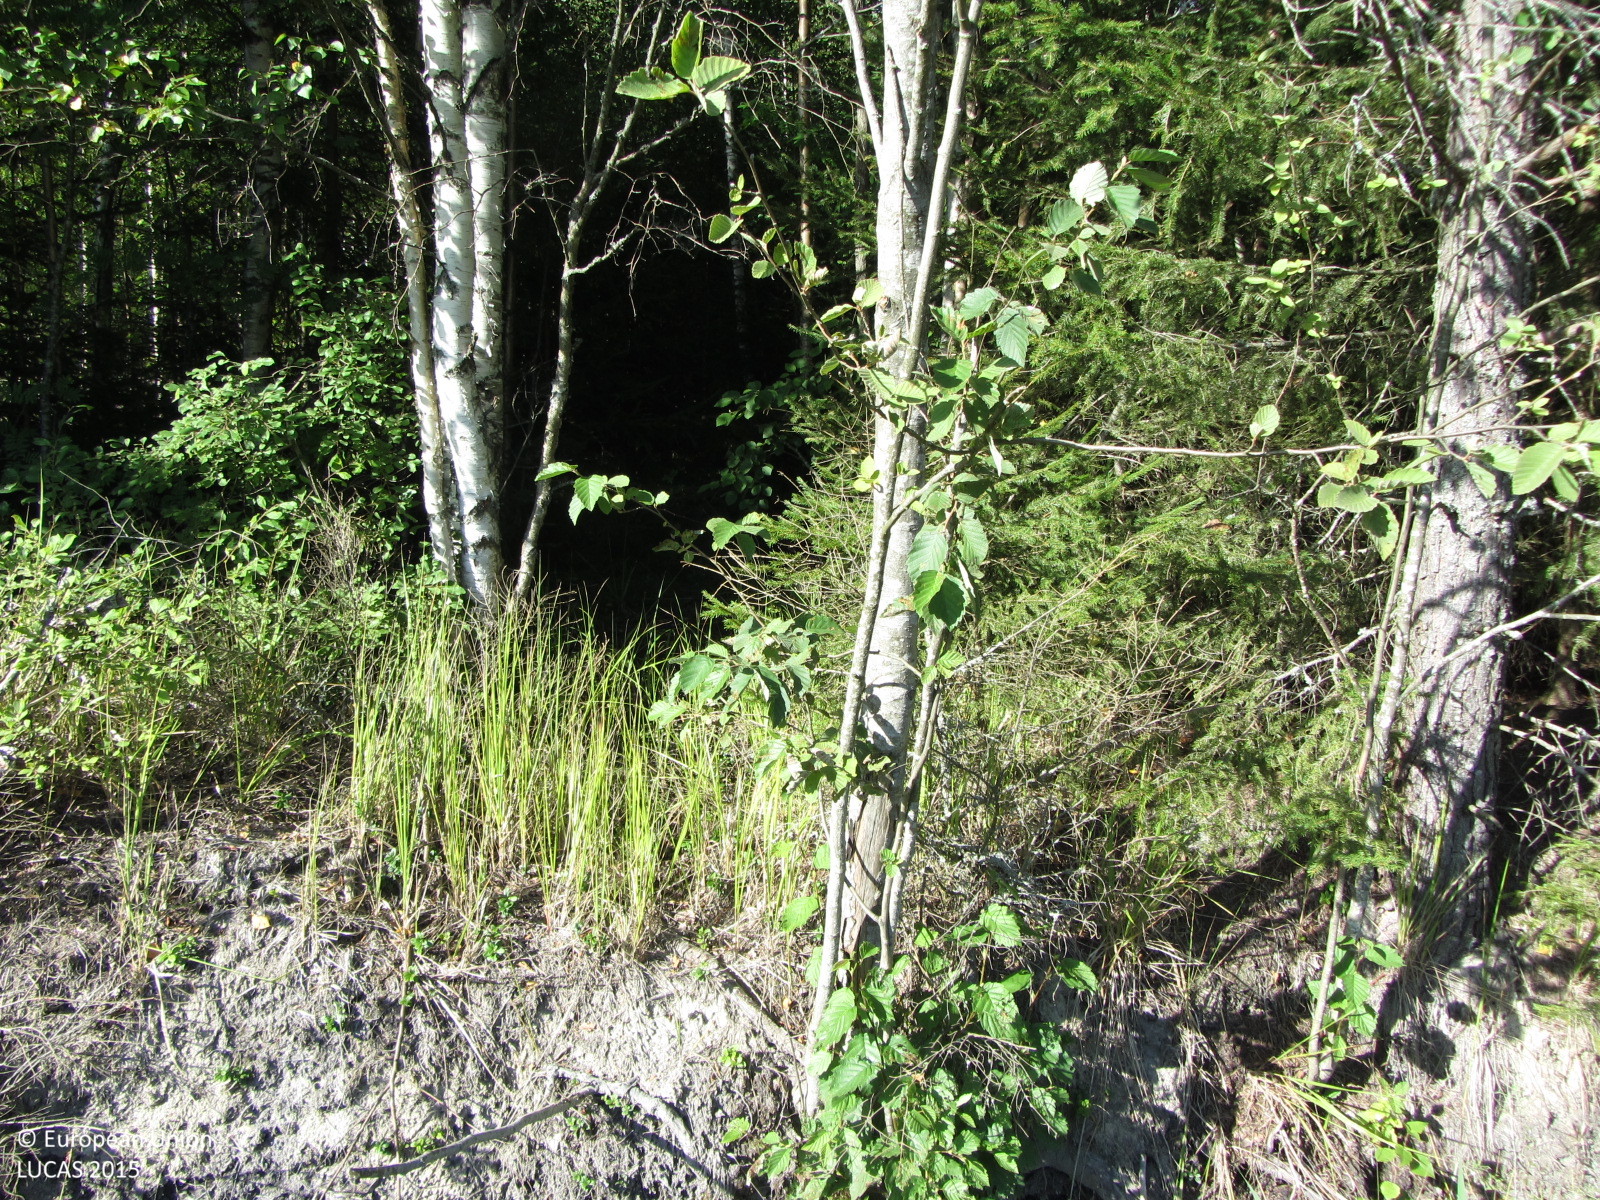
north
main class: Cropland
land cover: Barley
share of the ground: > 75 %
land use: Agriculture (excluding fallow land and kitchen gardens)
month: August
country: FI
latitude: 60.4771
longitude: 23.9026
